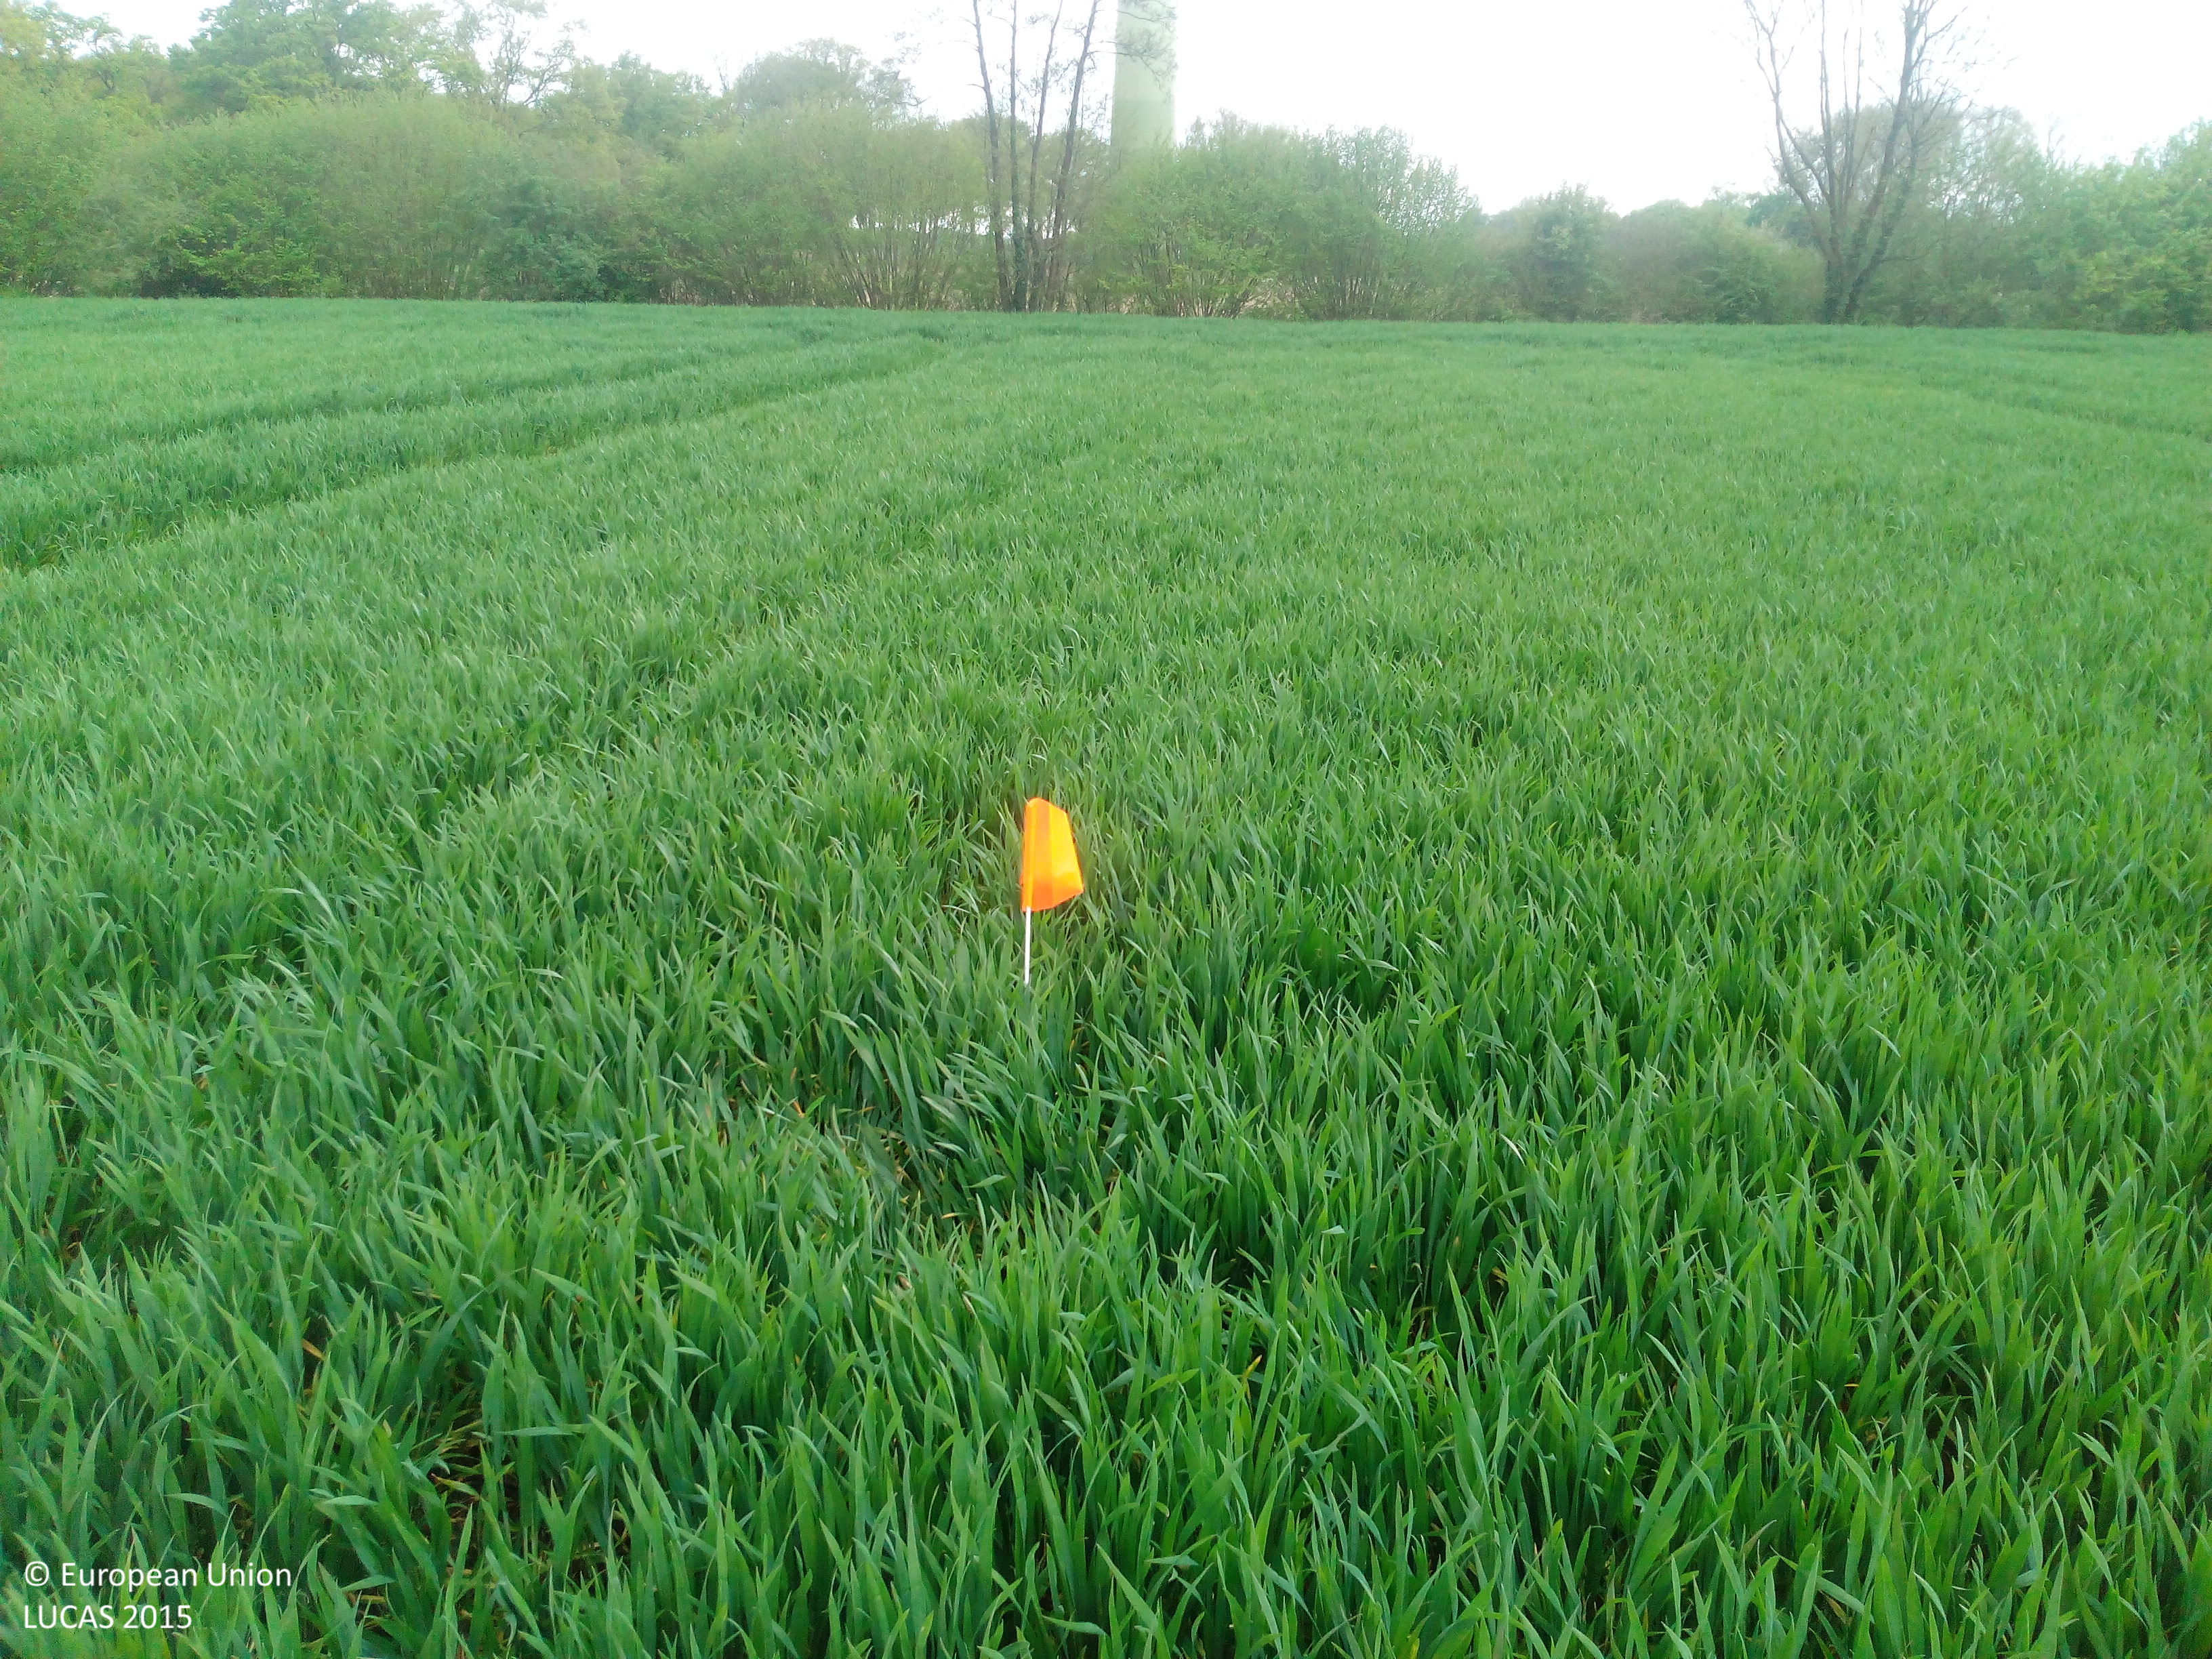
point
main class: Cropland
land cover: Triticale
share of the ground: > 75 %
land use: Agriculture (excluding fallow land and kitchen gardens)
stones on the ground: < 10 %
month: May
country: DE
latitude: 51.8635
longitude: 7.4009
